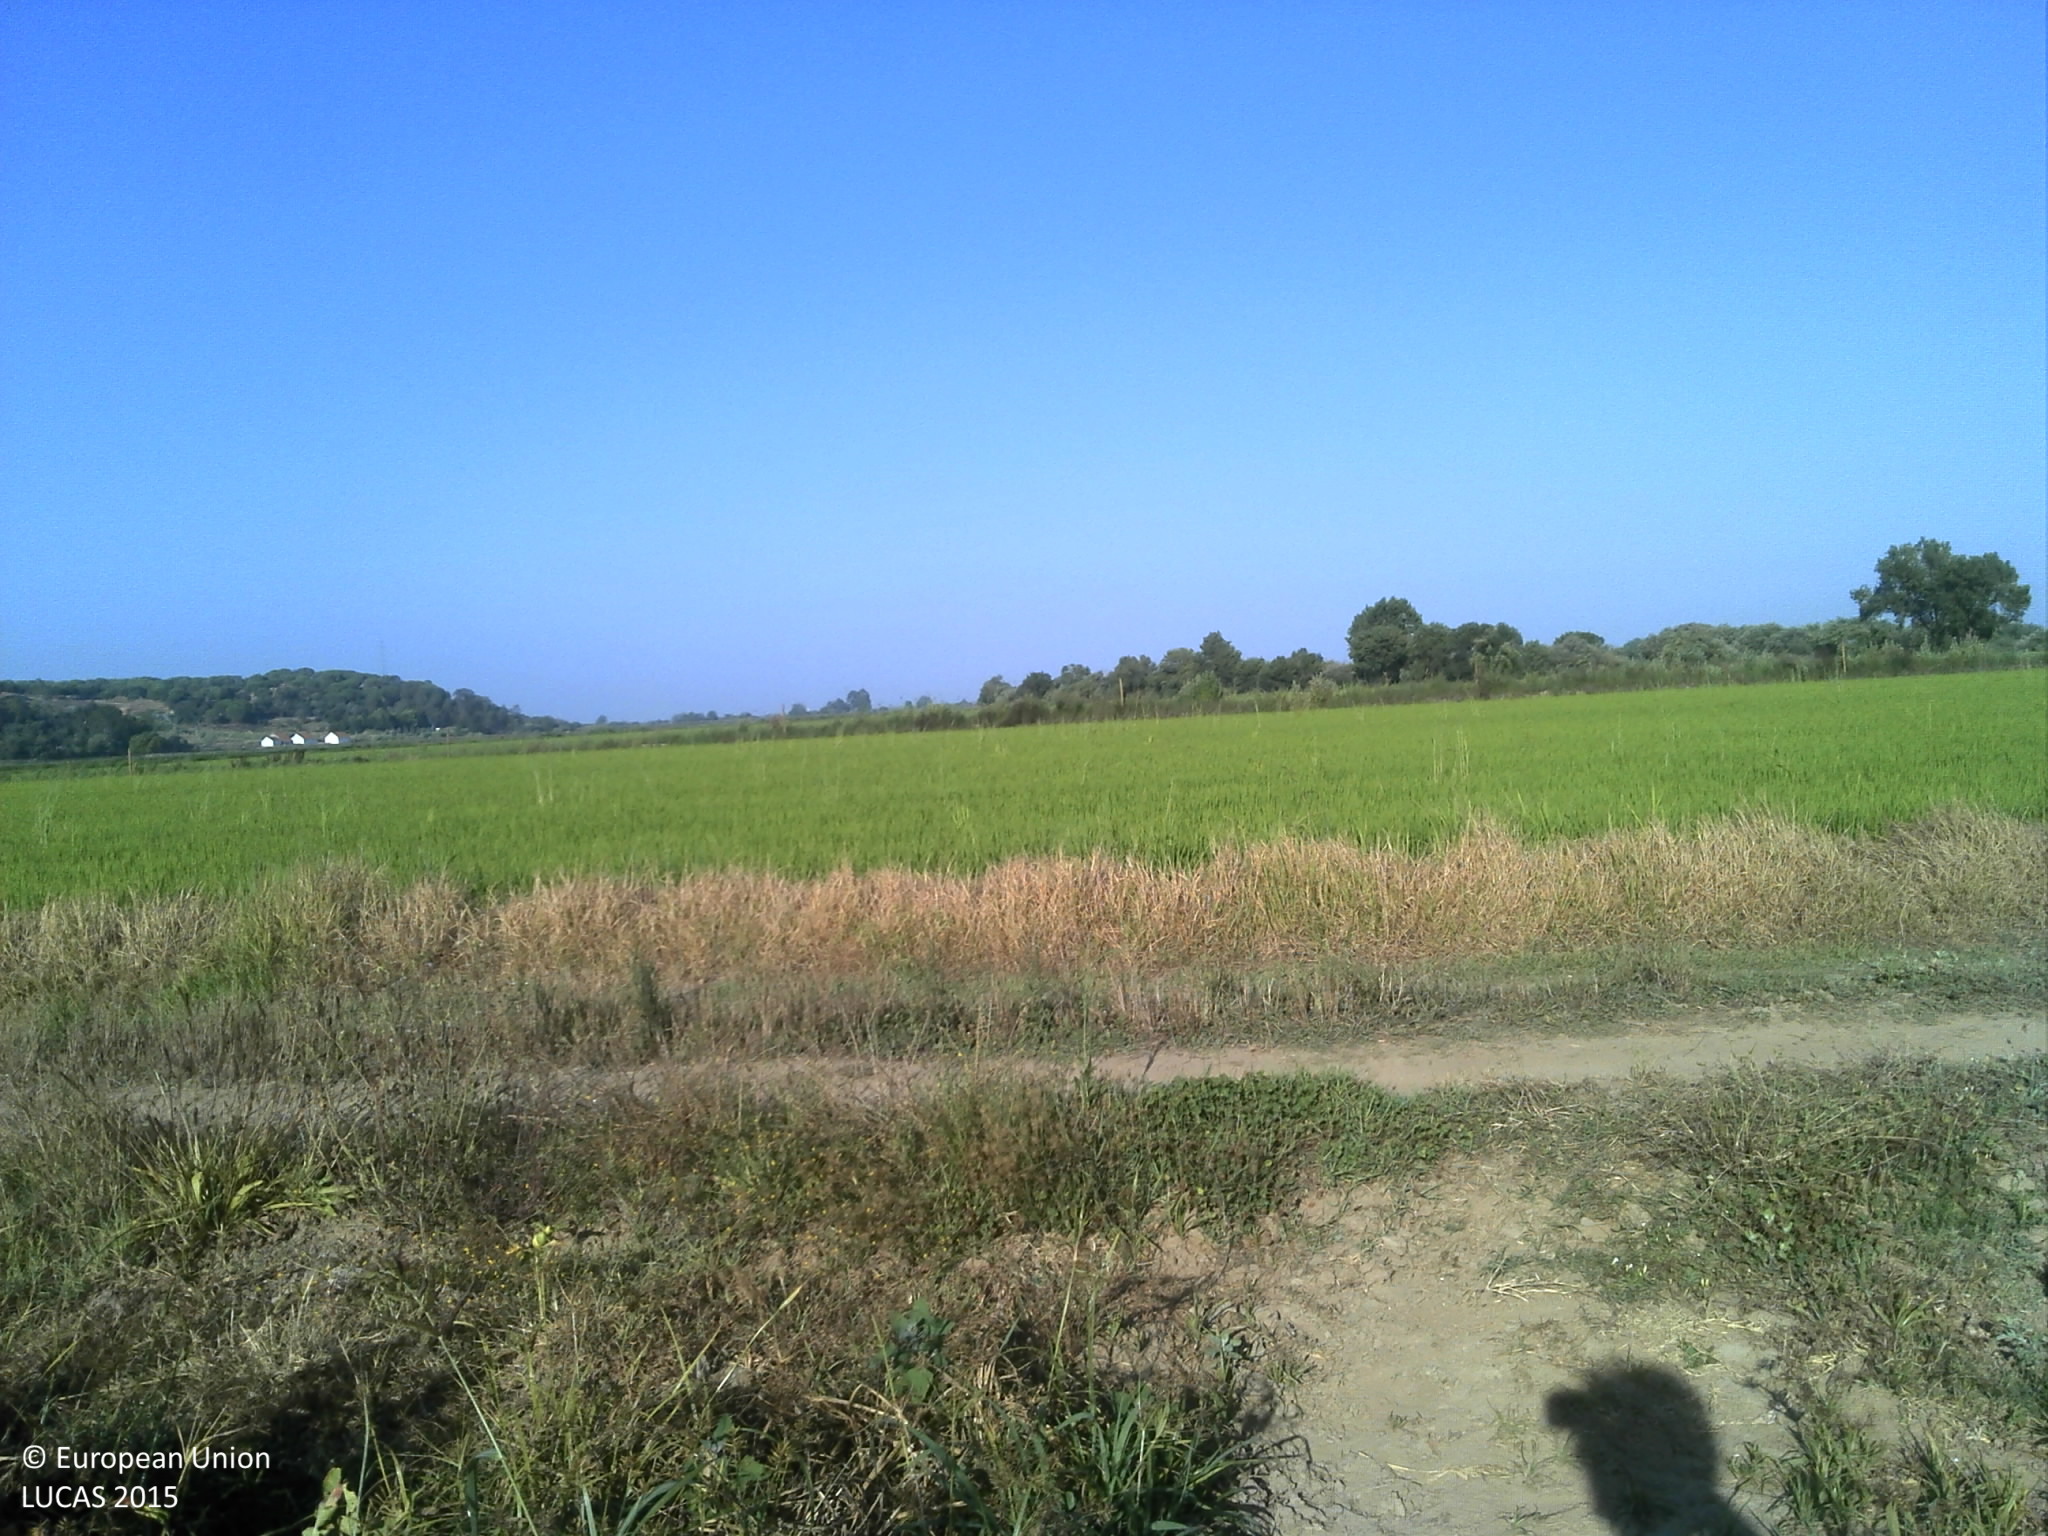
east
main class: Cropland
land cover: Potatoes
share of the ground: > 75 %
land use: Agriculture (excluding fallow land and kitchen gardens)
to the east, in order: Potatoes; Grass margins; Tracks; Grass margins; Rice; Grass margins; Ditches and canals; Grass margins; Rice
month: July
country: PT
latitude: 38.9376
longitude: -8.5800
